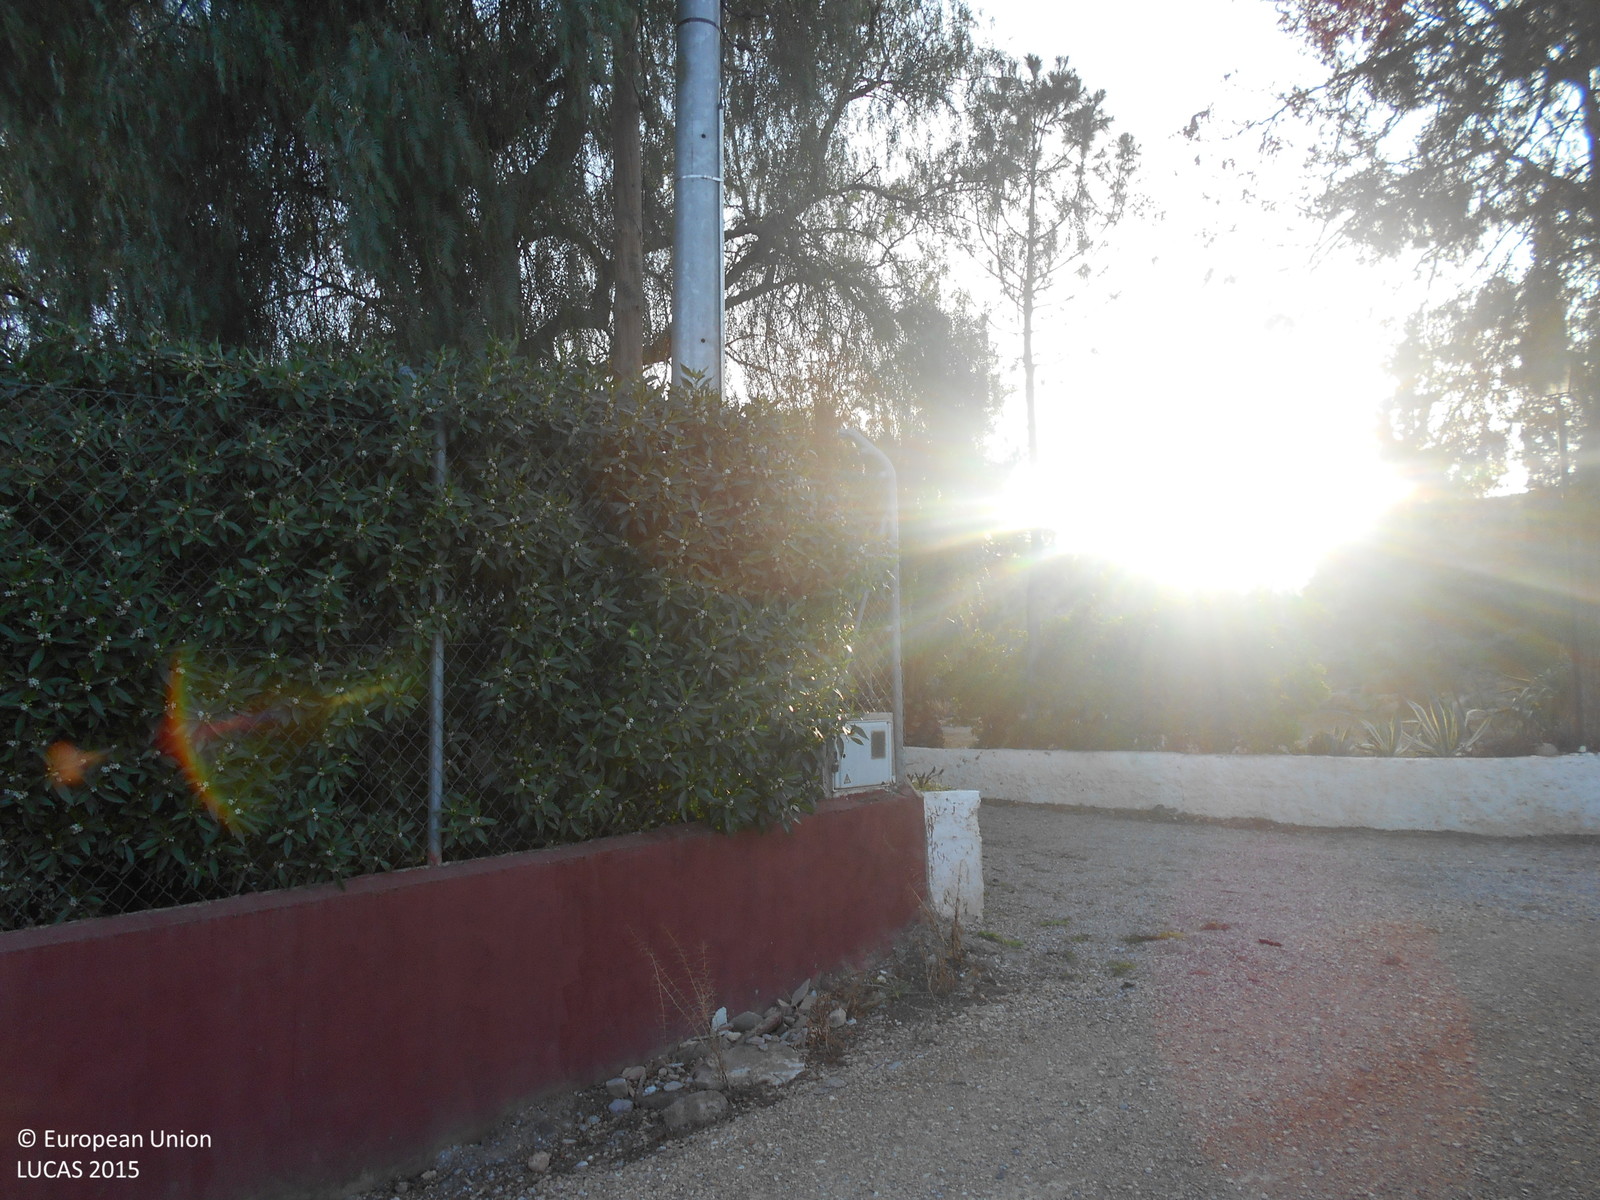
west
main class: Cropland
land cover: Nuts trees
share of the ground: 50 - 75 %
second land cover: Other bare soil
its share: > 75 %
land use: Agriculture (excluding fallow land and kitchen gardens)
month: April
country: ES
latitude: 37.7758
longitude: -1.5295
